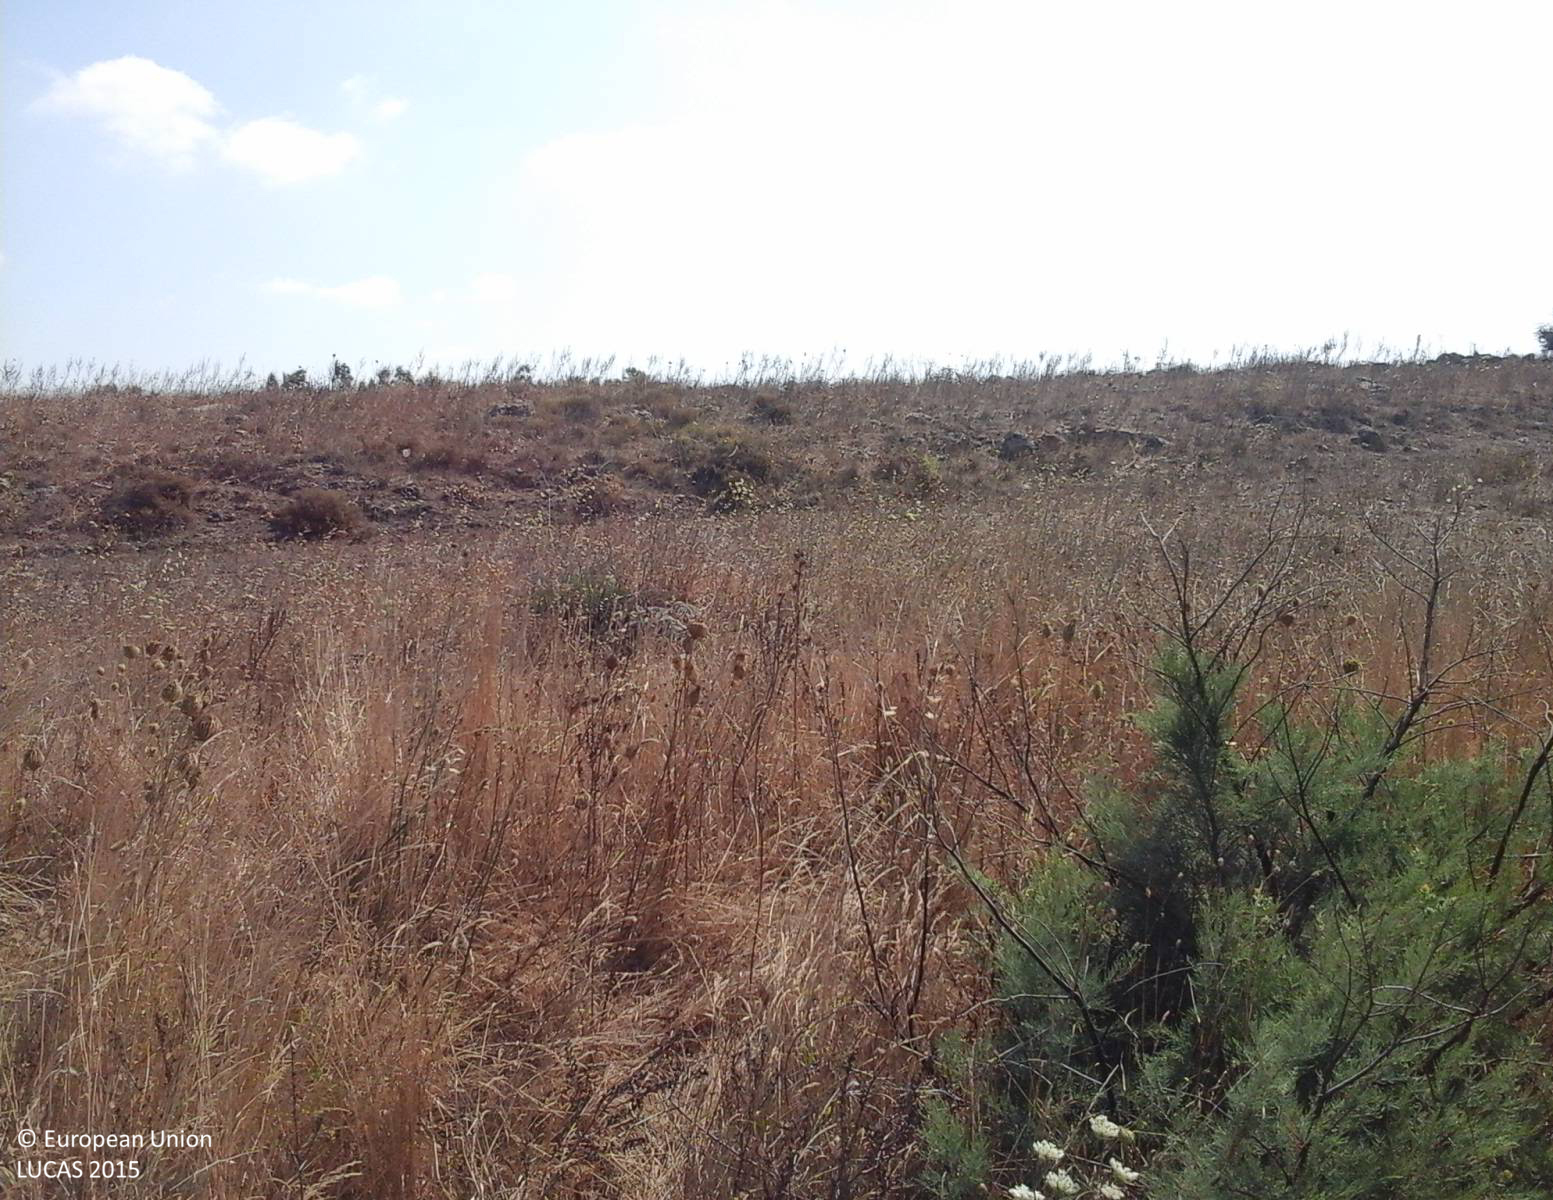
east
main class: Grassland
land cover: Spontaneously vegetated surfaces
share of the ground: > 75 %
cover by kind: herbaceous plants 100 %
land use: Agriculture (excluding fallow land and kitchen gardens)
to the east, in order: Spontaneously vegetated surfaces; Fences; Tracks; Grass margins; Fences; Spontaneously vegetated surfaces; Olive groves; Spontaneously vegetated surfaces; Olive groves
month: July
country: IT
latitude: 39.6452
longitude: 8.8762
